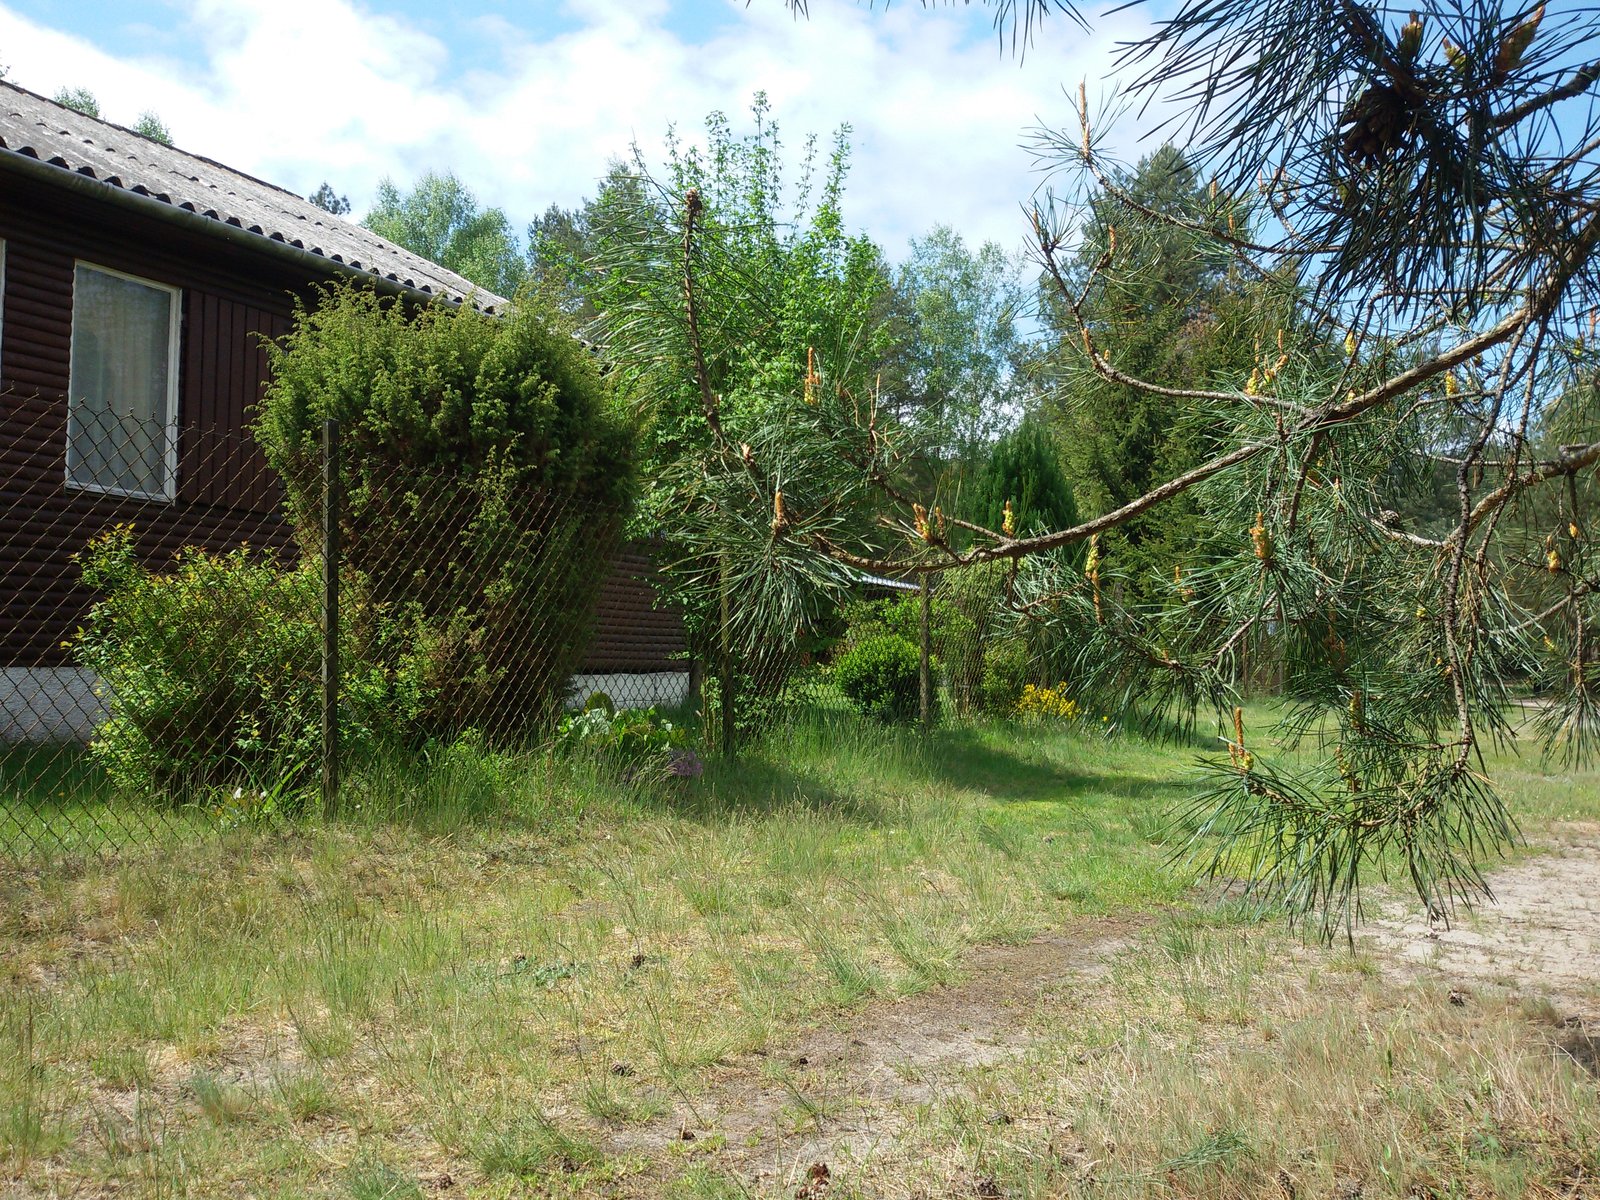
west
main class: Woodland
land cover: Pine dominated coniferous woodland
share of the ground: > 75 %
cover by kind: coniferous forest trees 75 %, lichens and mosses 15 %, unconsolidated bare surface 10 %
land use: Forestry
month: May
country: PL
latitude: 51.7410
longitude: 21.1543
